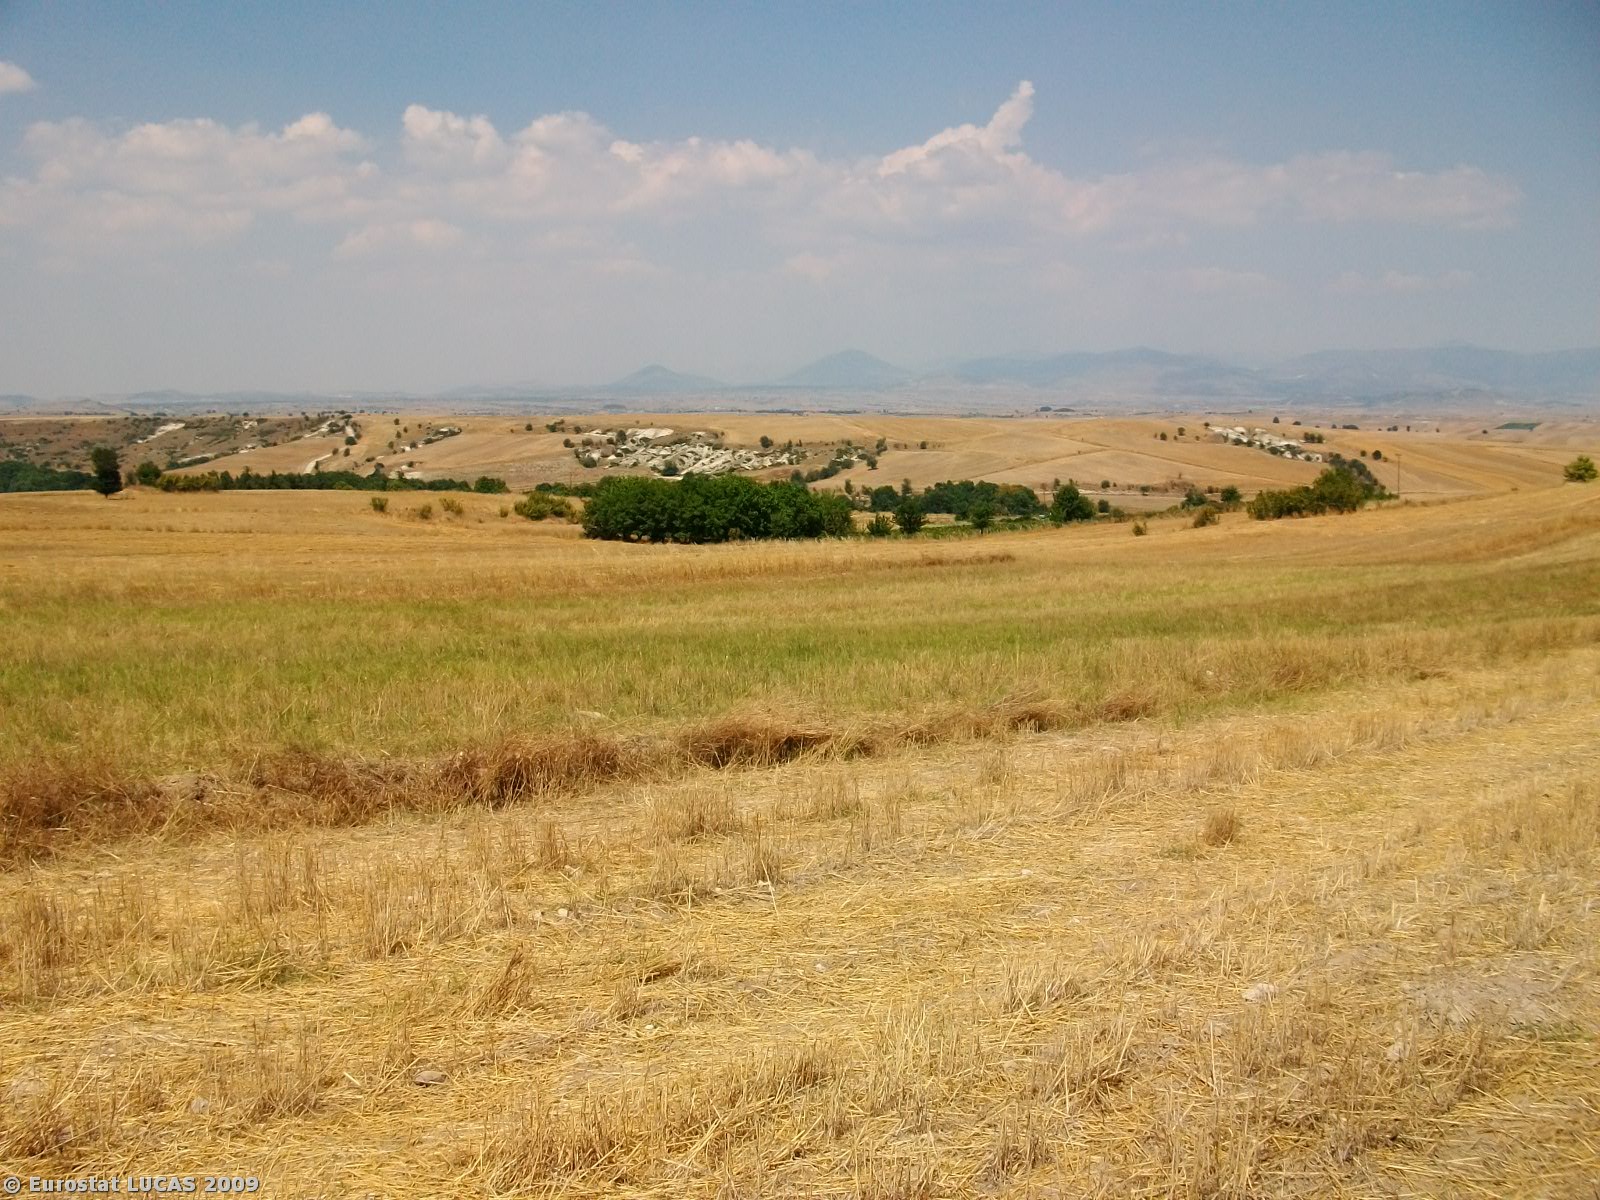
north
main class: Cropland
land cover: Durum wheat
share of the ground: < 10 %
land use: Agriculture (excluding fallow land and kitchen gardens)
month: July
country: GR
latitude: 40.1717
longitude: 21.8156
